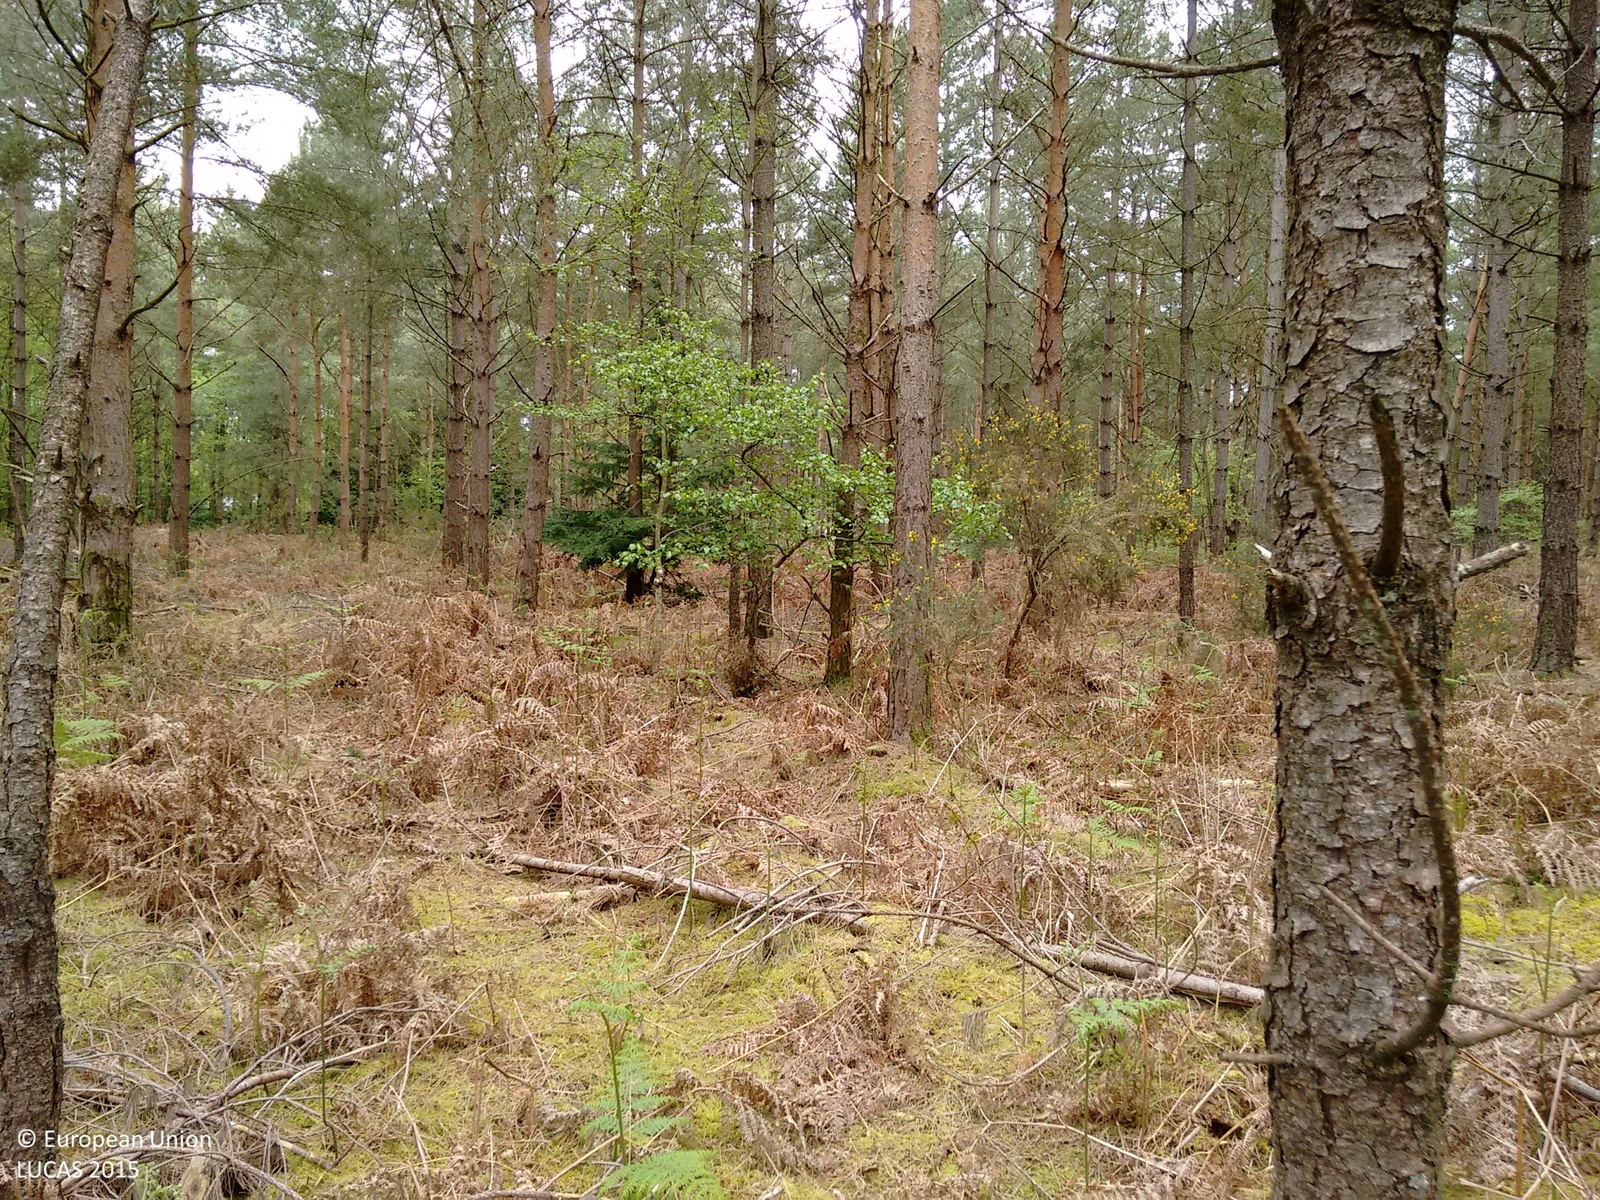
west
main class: Woodland
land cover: Pine dominated coniferous woodland
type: hemiboreal forest and nemoral coniferous forest and mixed broadleaved-coniferous forest
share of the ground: > 75 %
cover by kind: coniferous forest trees 100 %
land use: Forestry
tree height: > 5 m
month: May
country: GB
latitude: 50.8002
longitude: -1.8467
